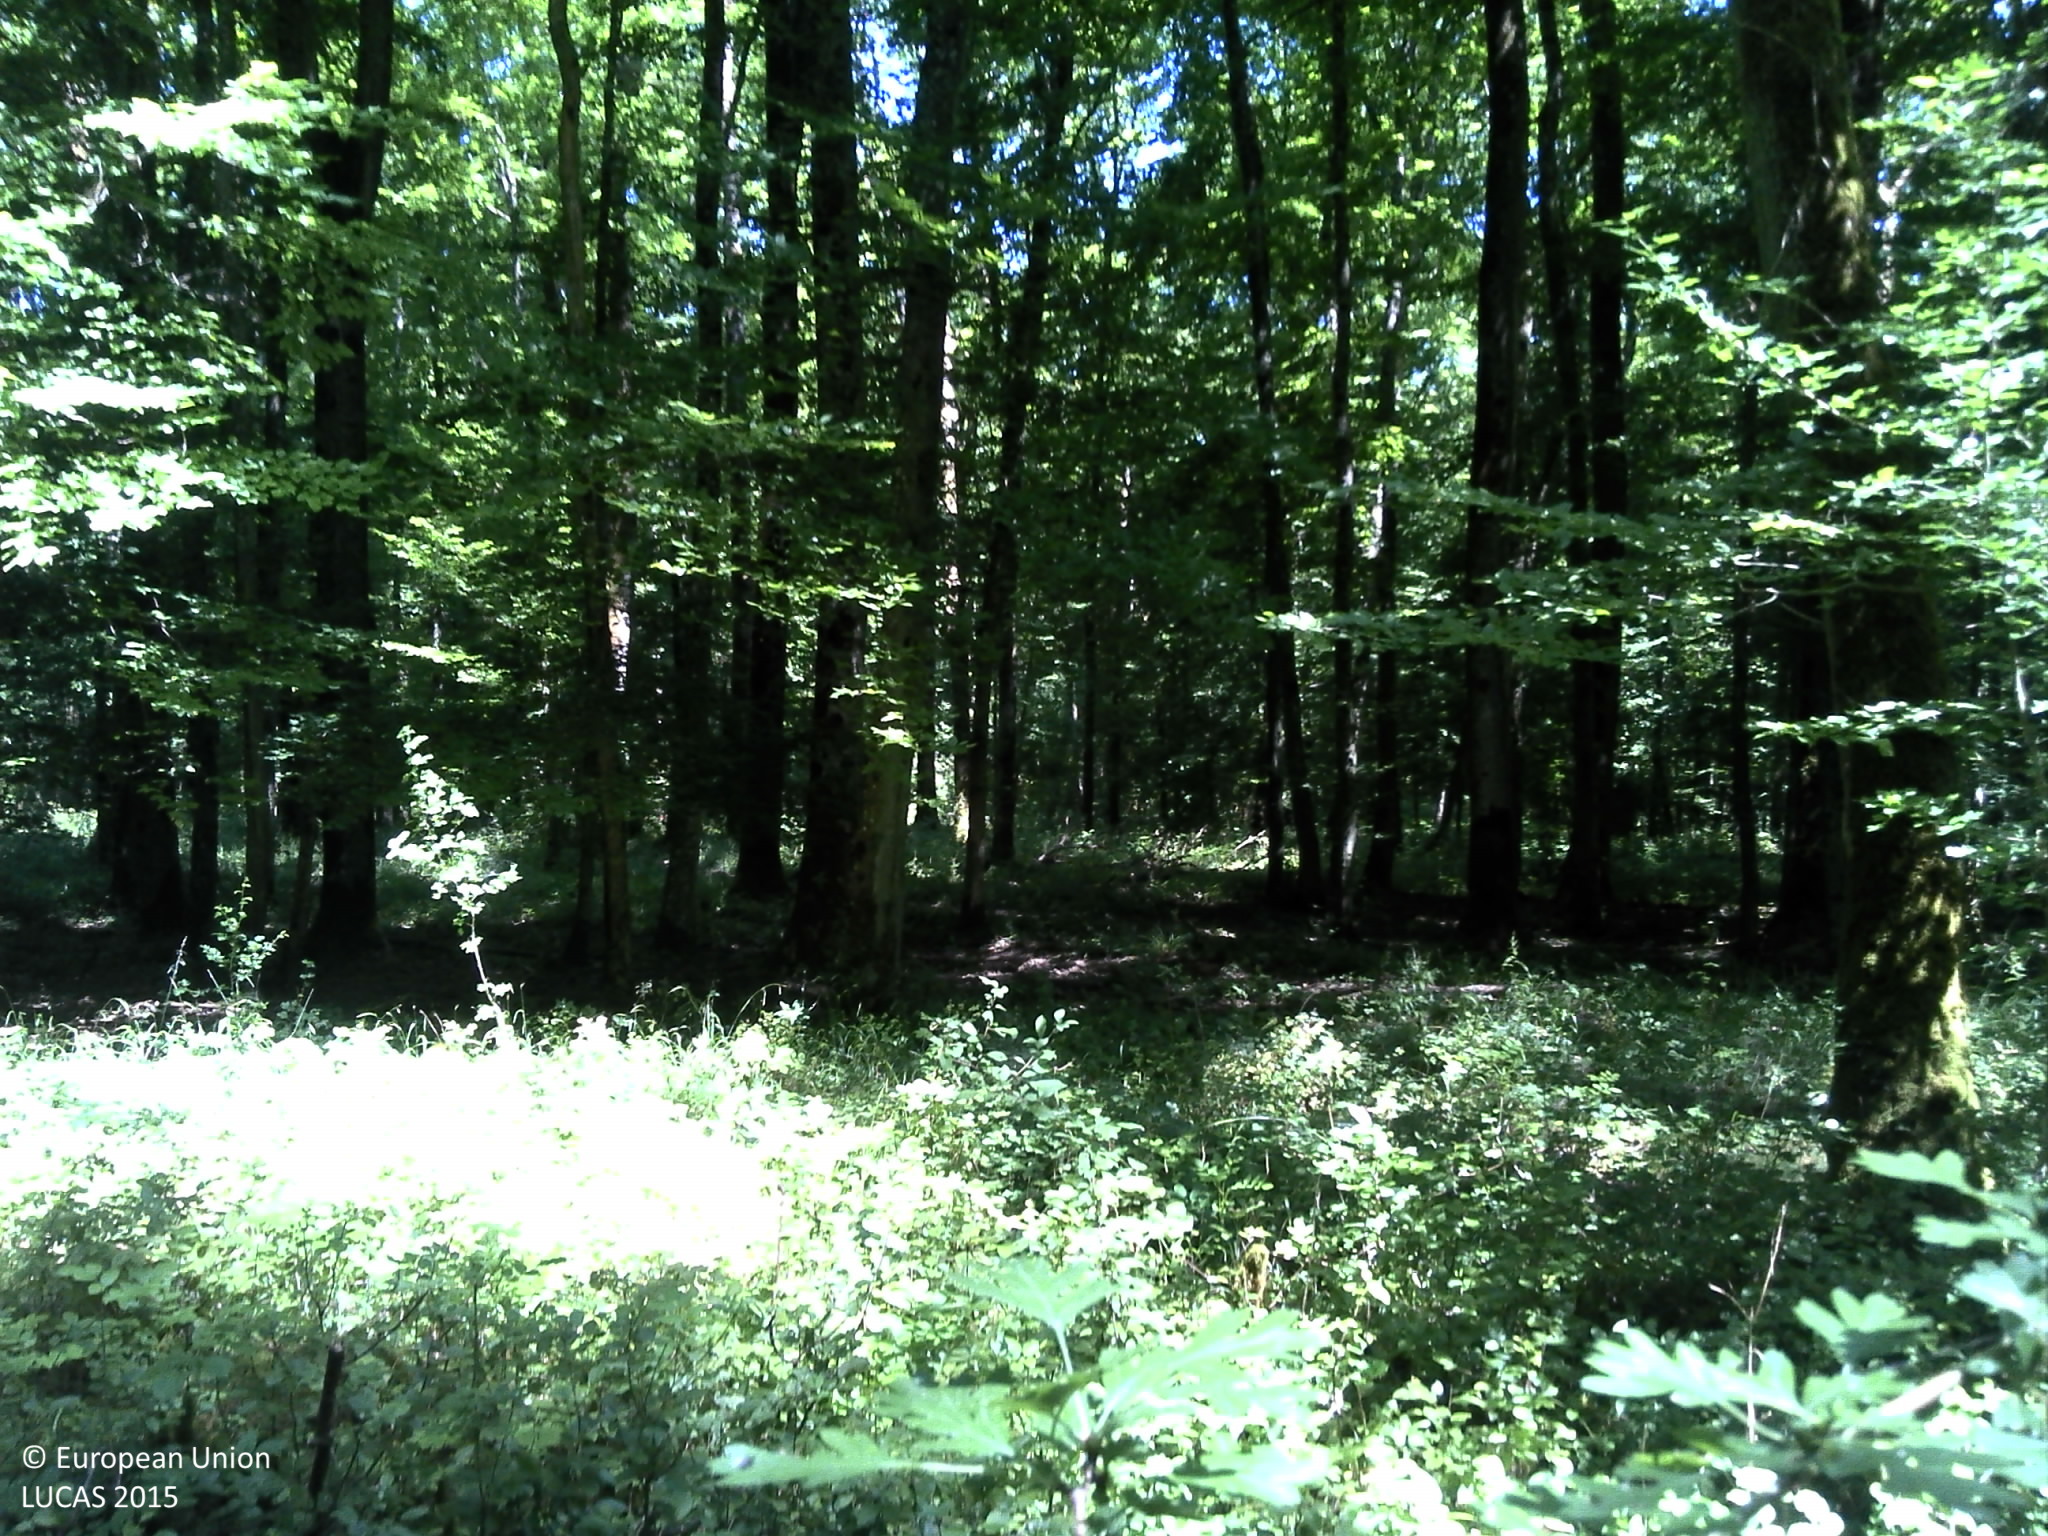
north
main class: Woodland
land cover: Broadleaved woodland
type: mesophytic deciduous forest
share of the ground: > 75 %
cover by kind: broadleaved forest trees 95 %, herbaceous plants 5 %
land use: Forestry
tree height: > 5 m
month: June
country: FR
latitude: 49.3804
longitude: 6.1289
